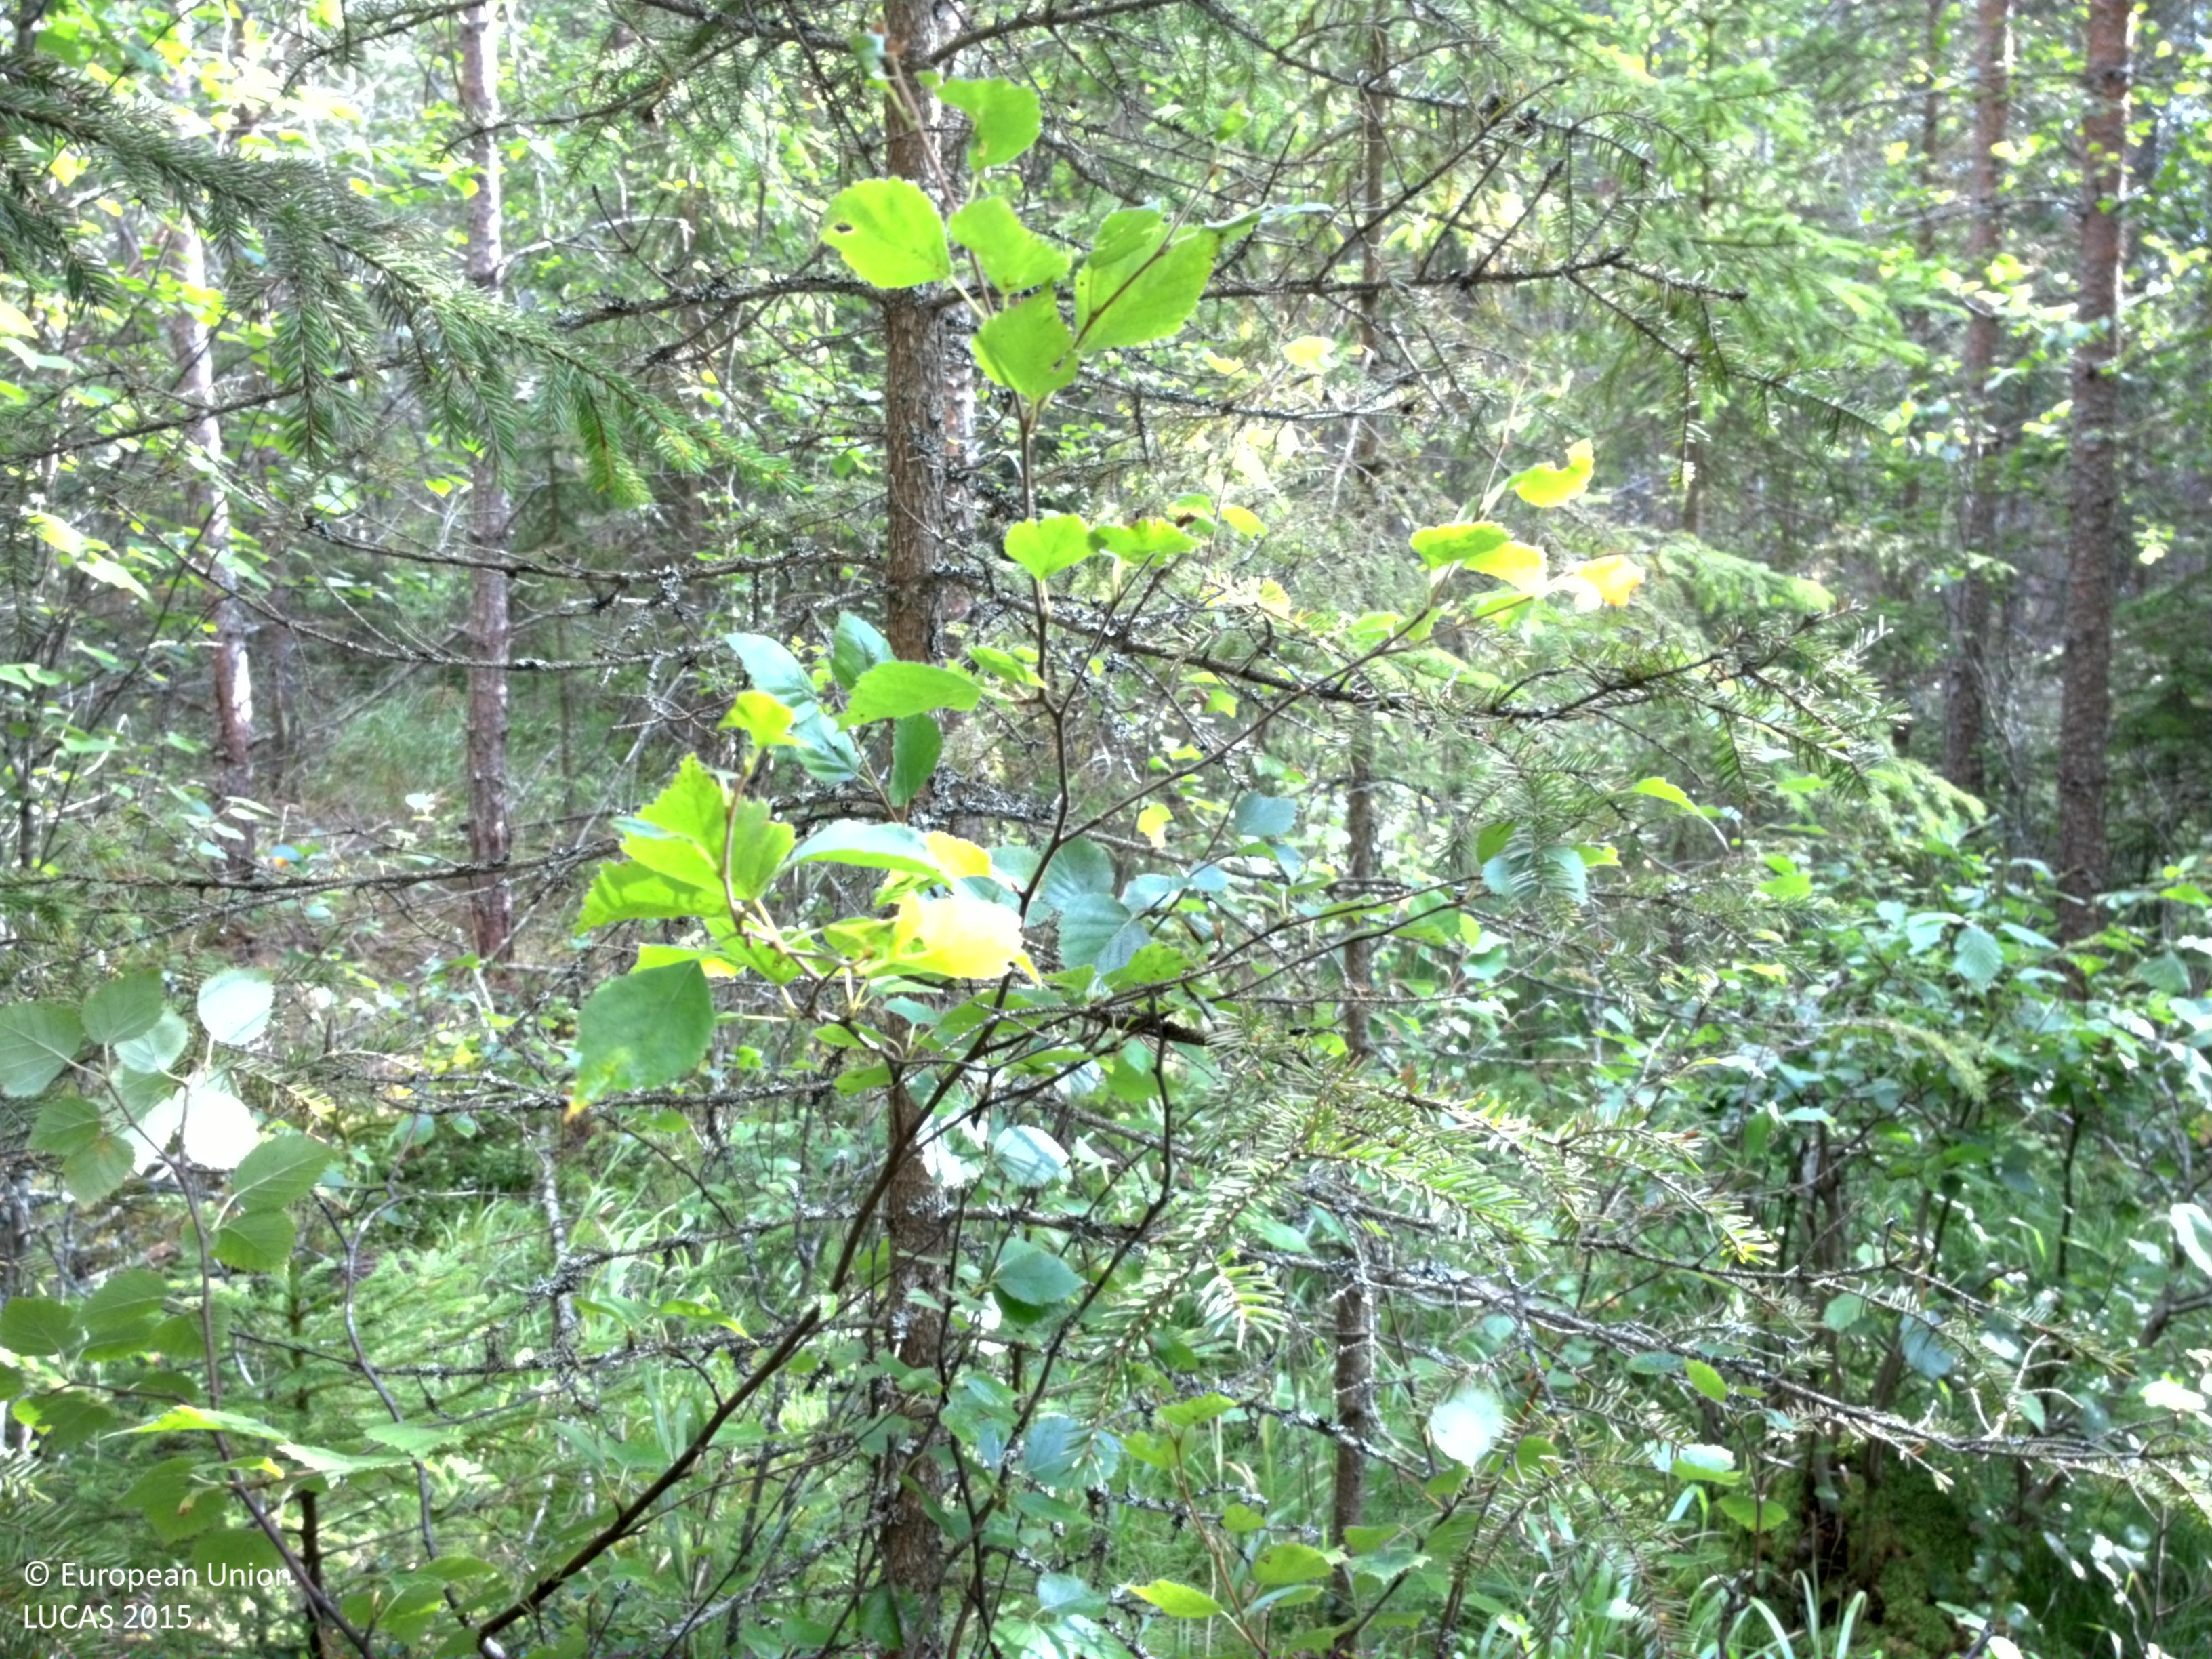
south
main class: Woodland
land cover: Other mixed woodland
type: boreal forest
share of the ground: > 75 %
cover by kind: coniferous forest trees 45 %, broadleaved forest trees 35 %, shrubs 10 %, herbaceous plants 5 %, lichens and mosses 5 %
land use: Forestry
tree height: > 5 m
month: August
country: SE
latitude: 60.0627
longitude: 14.2472
